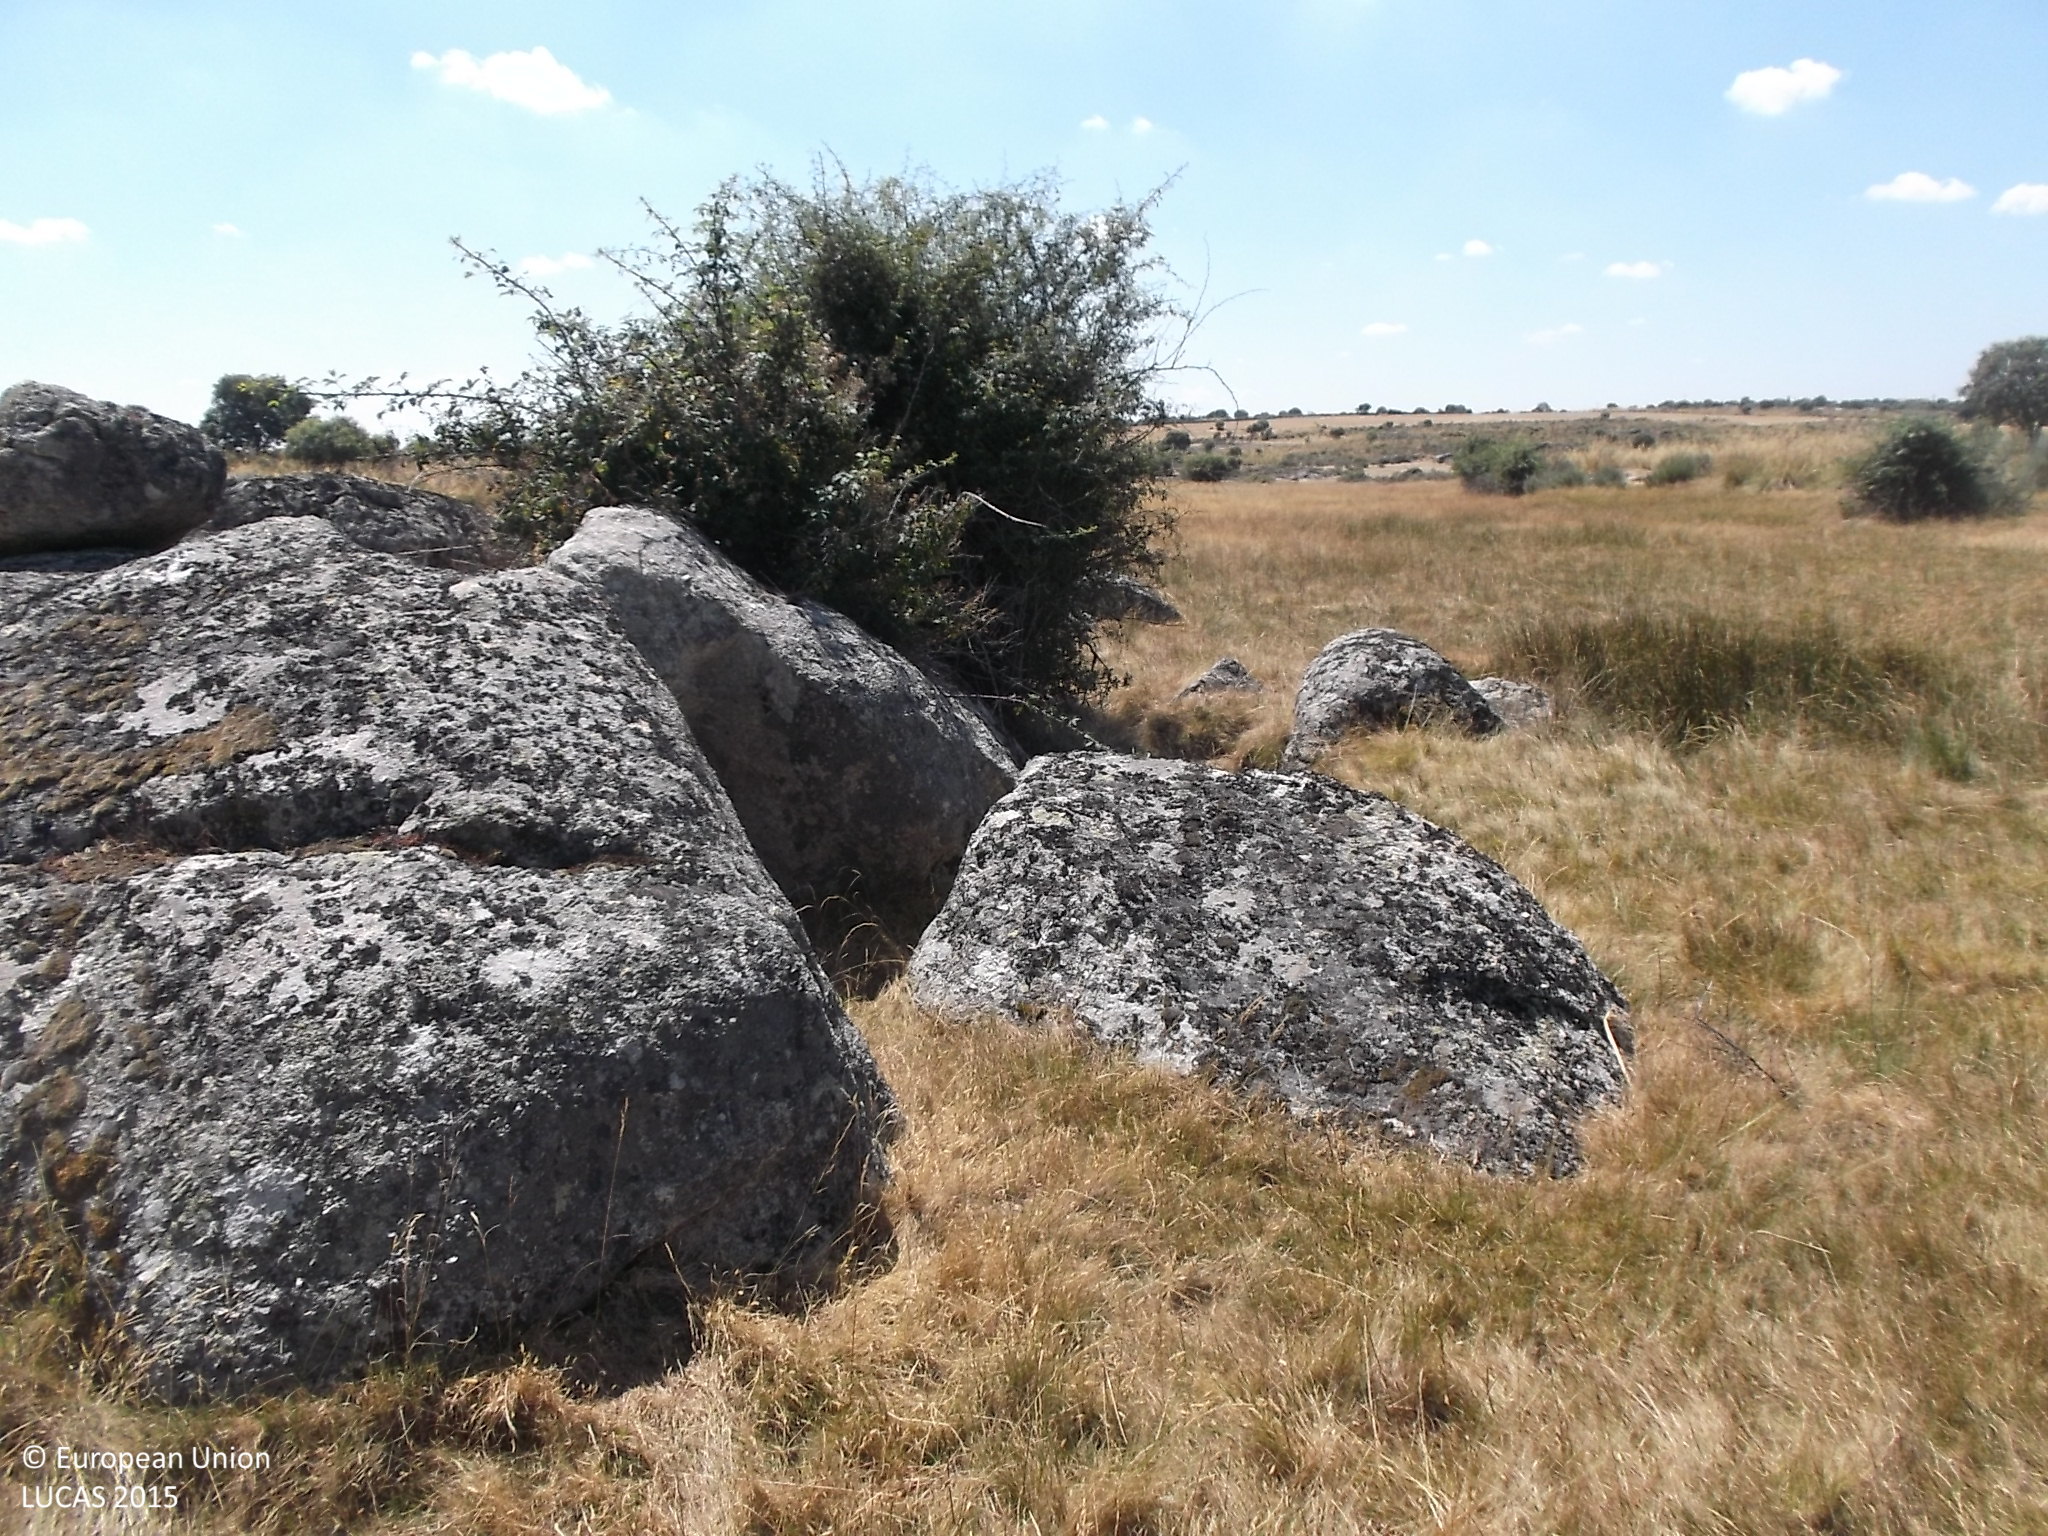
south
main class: Grassland
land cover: Grassland without tree/shrub cover
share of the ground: > 75 %
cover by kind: herbaceous plants 100 %
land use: Agriculture (excluding fallow land and kitchen gardens)
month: July
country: ES
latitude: 41.4210
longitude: -6.0407
